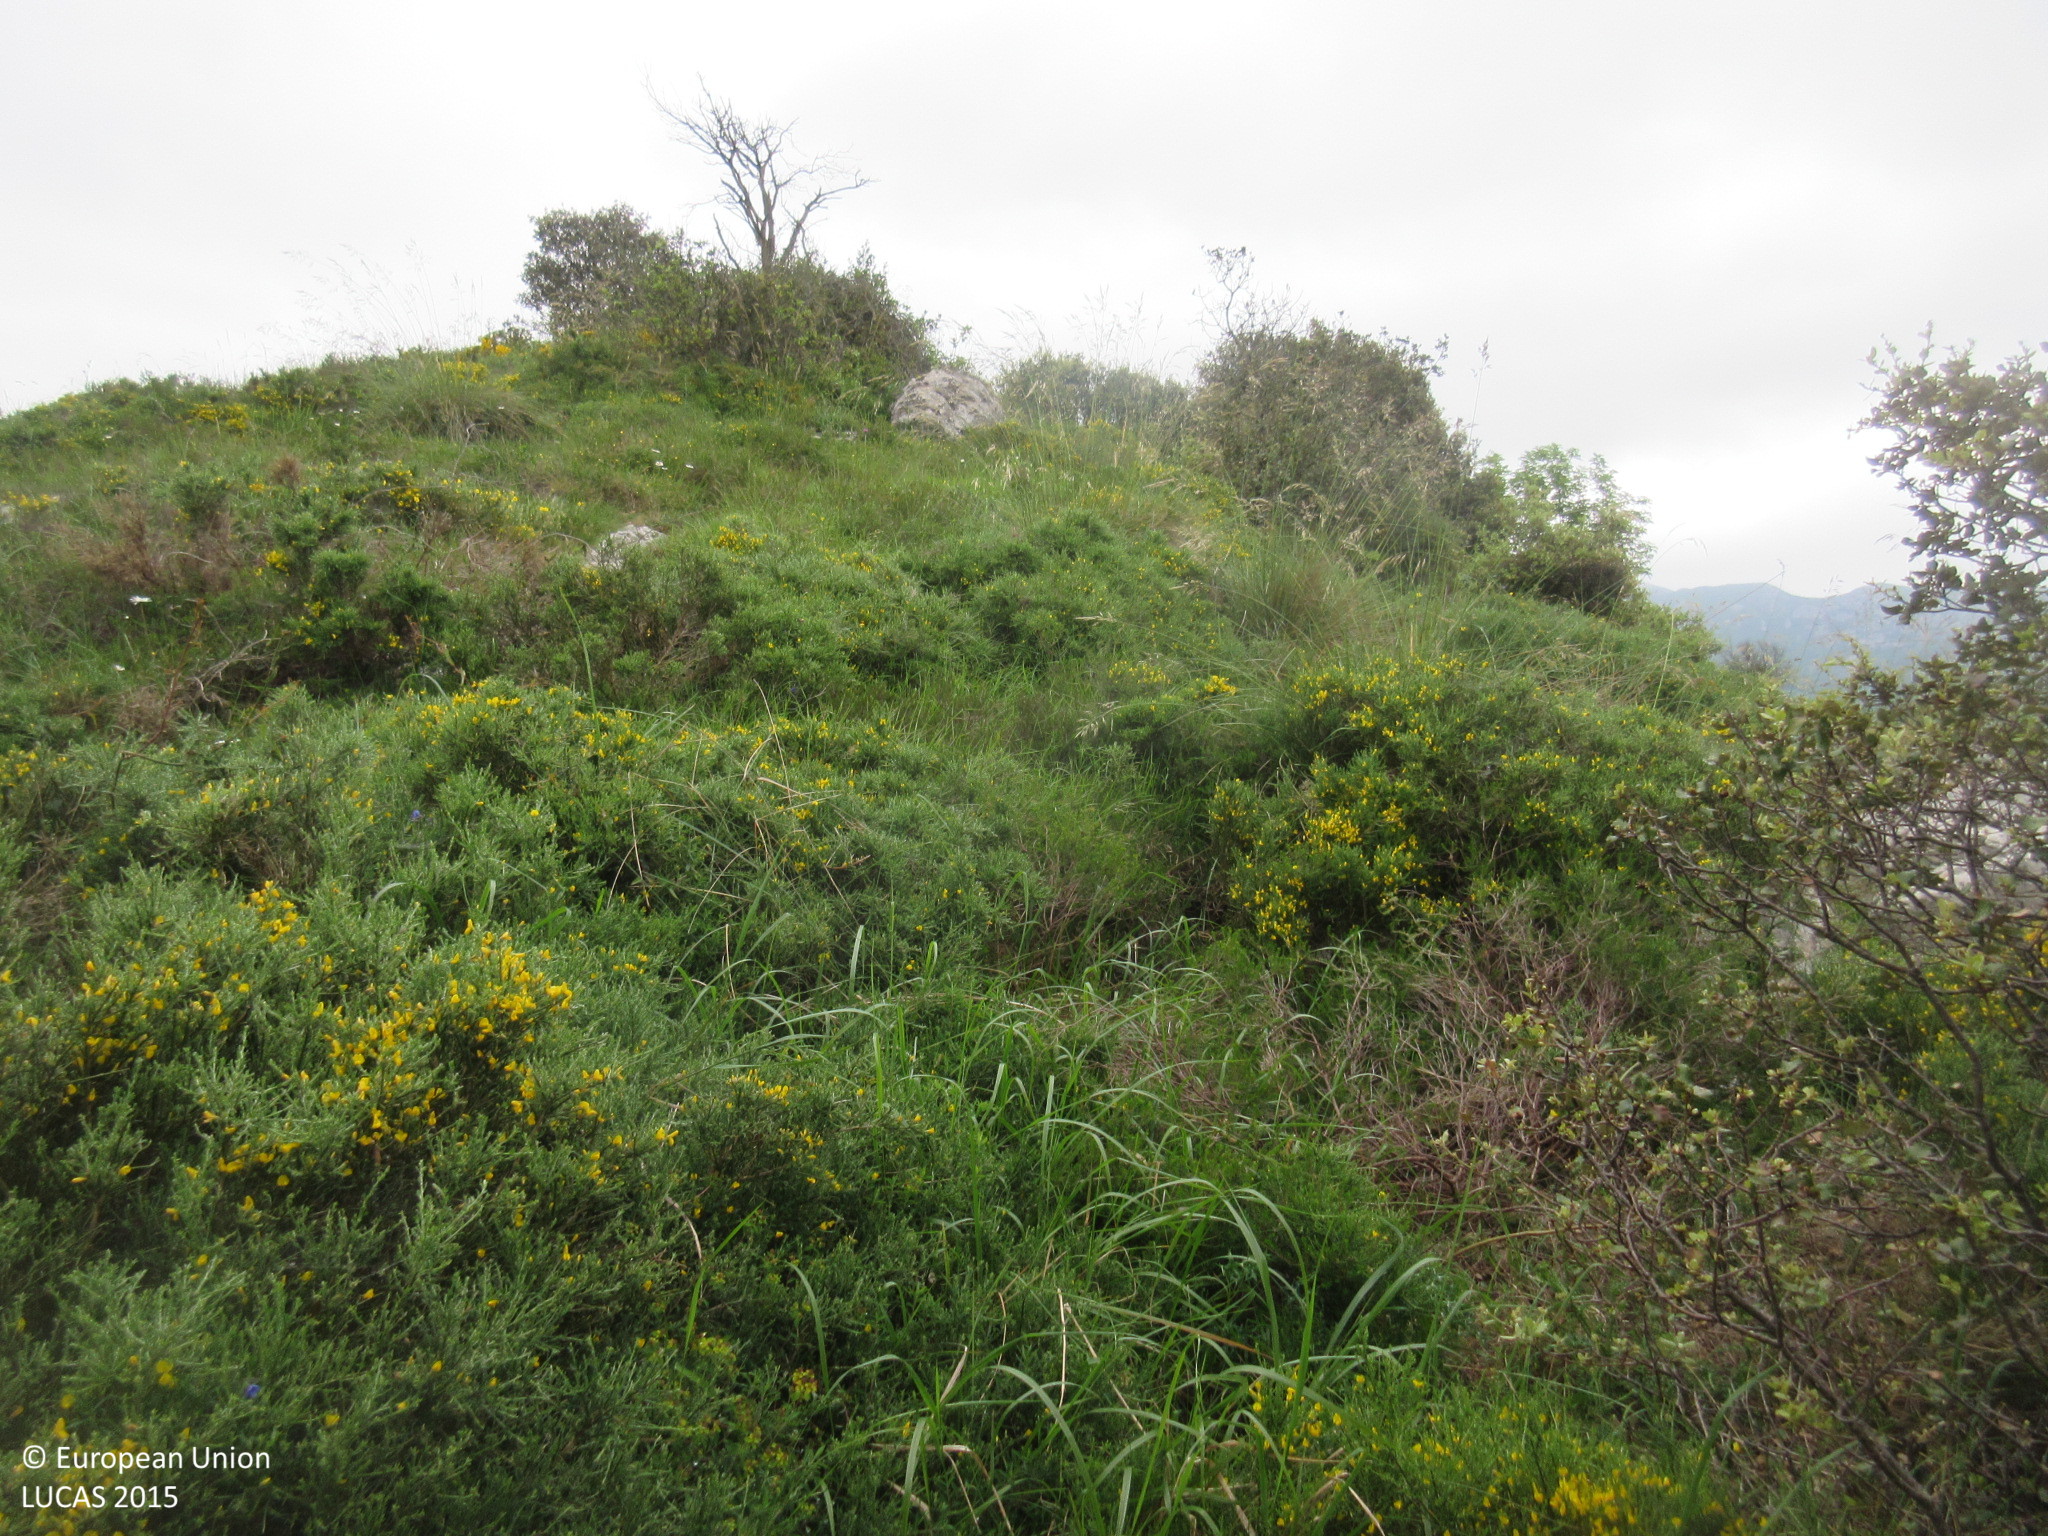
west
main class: Shrubland
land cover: Shrubland with sparse tree cover
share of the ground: > 75 %
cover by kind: shrubs 95 %, broadleaved forest trees 5 %
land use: Semi-natural and natural areas not in use
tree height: < 5 m
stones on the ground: > 50 %
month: May
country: ES
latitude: 43.3117
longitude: -4.5977
